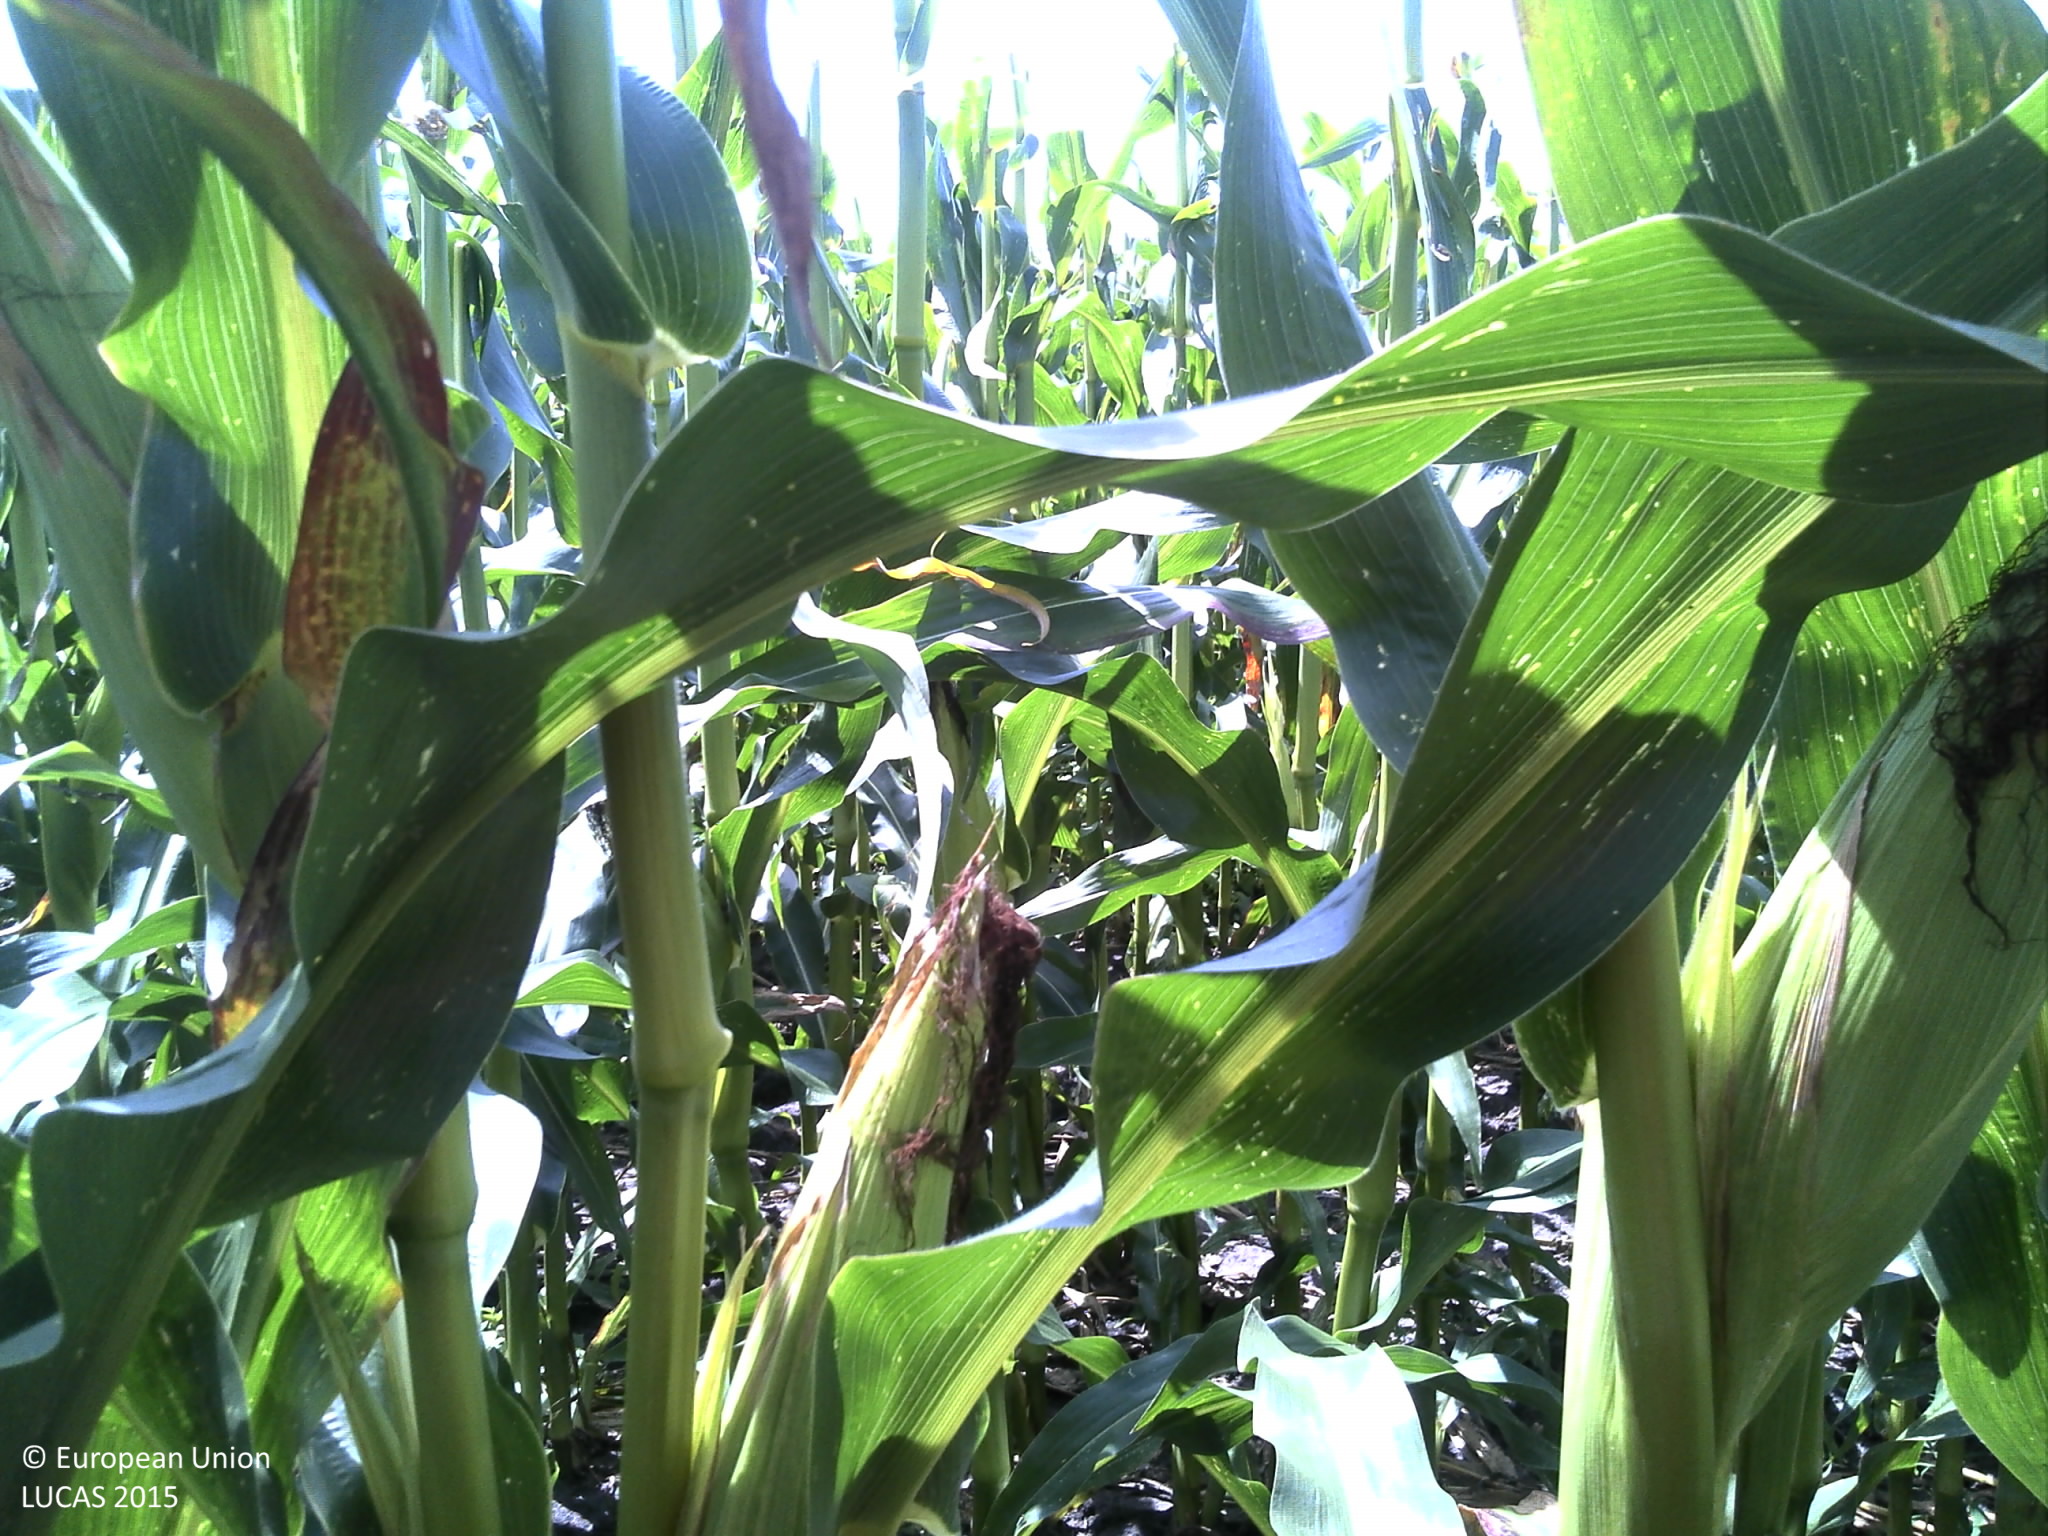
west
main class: Cropland
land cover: Maize
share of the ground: > 75 %
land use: Agriculture (excluding fallow land and kitchen gardens)
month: July
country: FR
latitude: 44.2526
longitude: -0.3200
